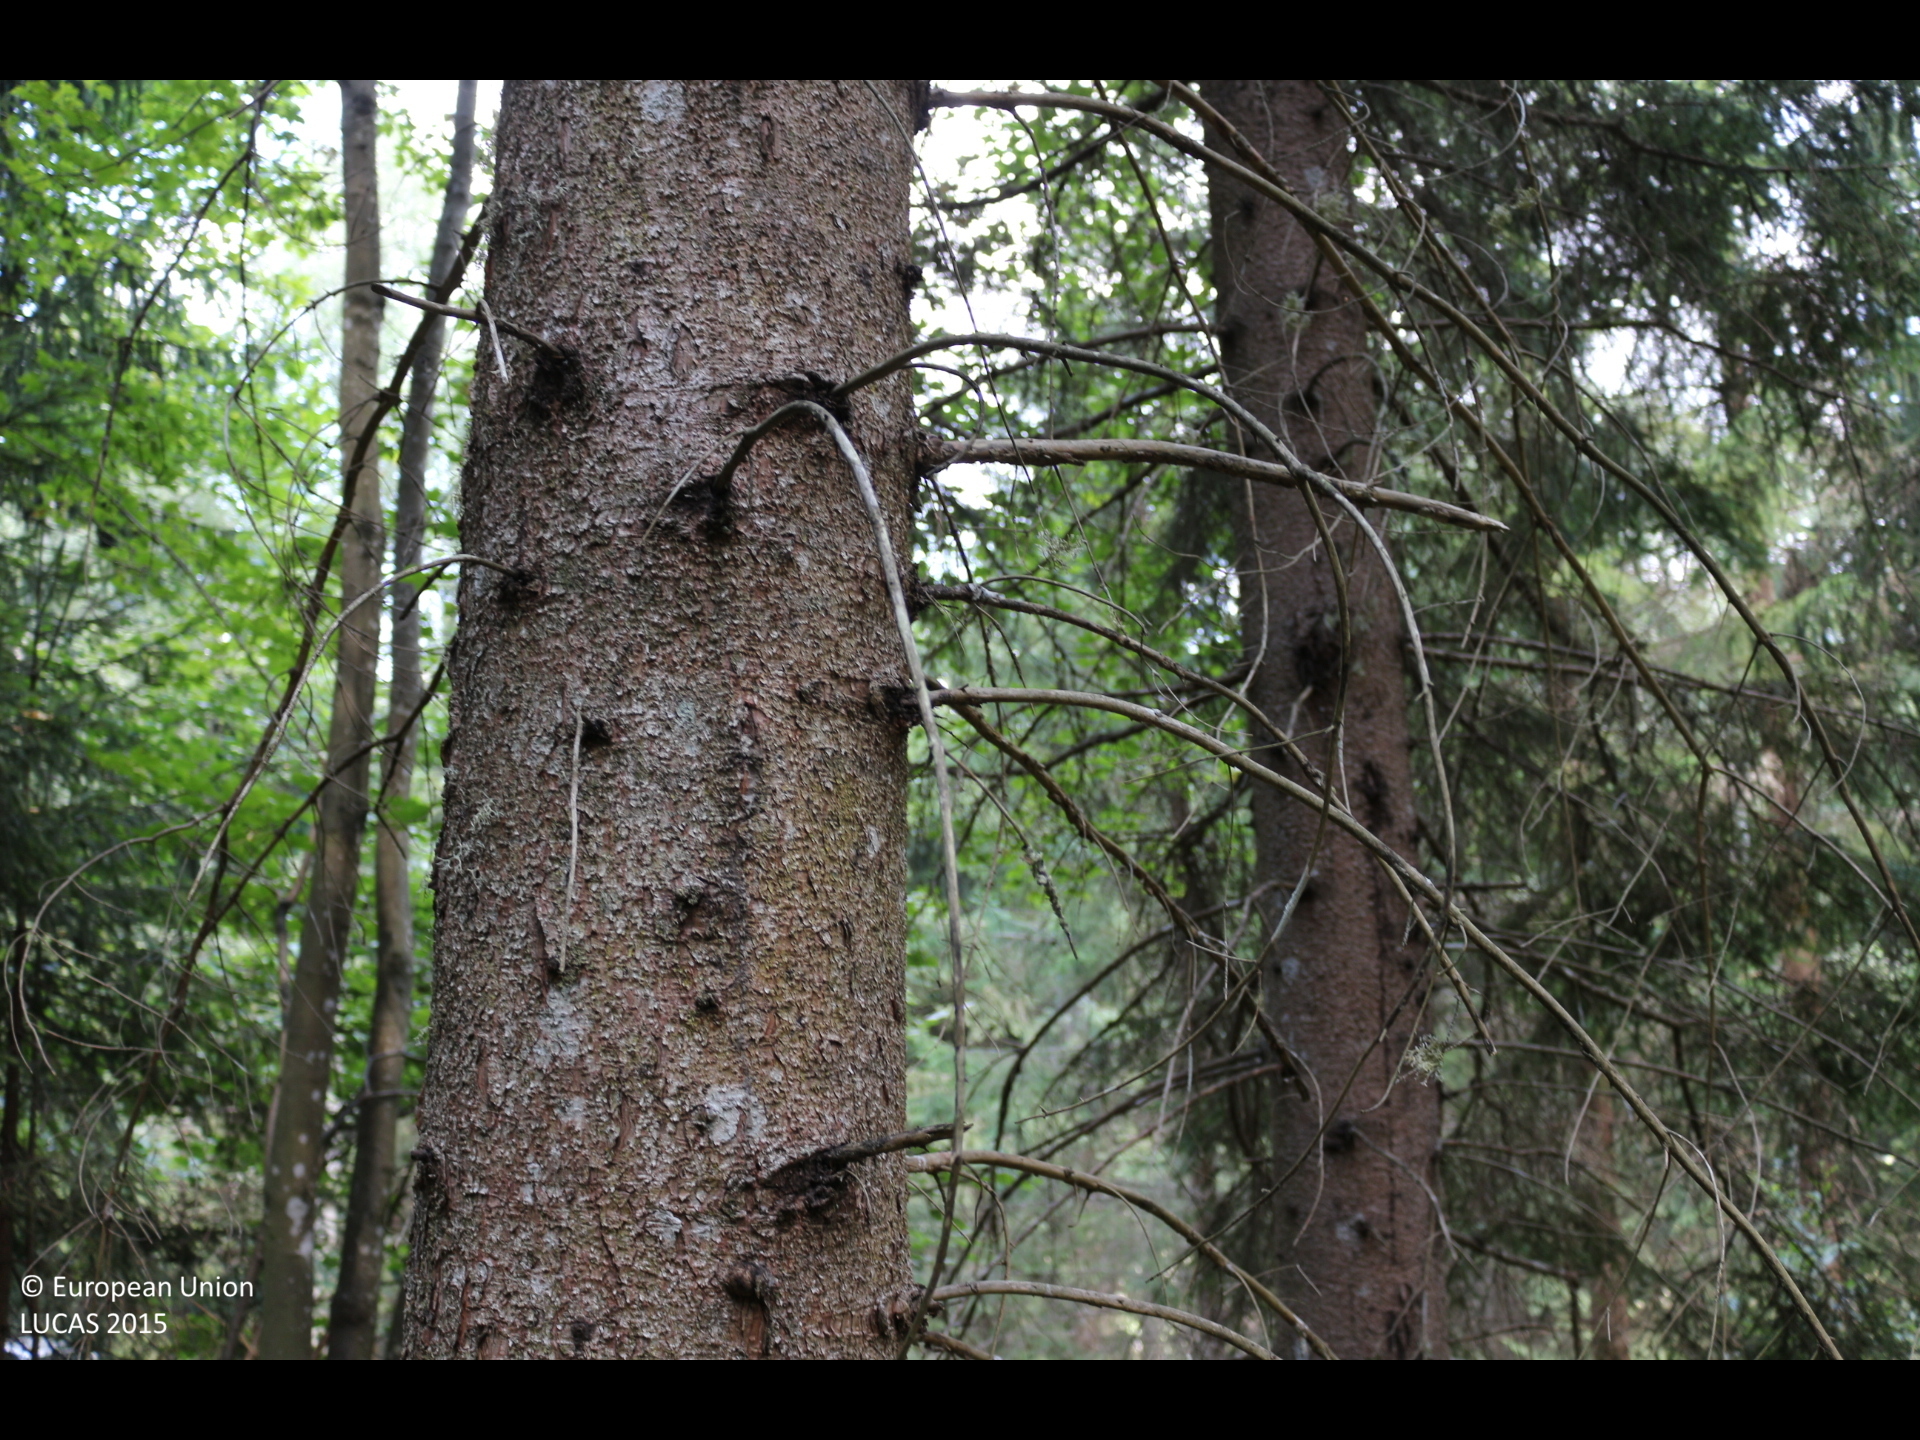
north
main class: Woodland
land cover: Spruce dominated coniferous woodland
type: alpine coniferous forest
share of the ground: > 75 %
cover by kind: coniferous forest trees 90 %, broadleaved forest trees 5 %, herbaceous plants 5 %
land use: Forestry
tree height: > 5 m
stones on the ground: 10 - 25 %
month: August
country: AT
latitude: 46.8855
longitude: 14.1053
